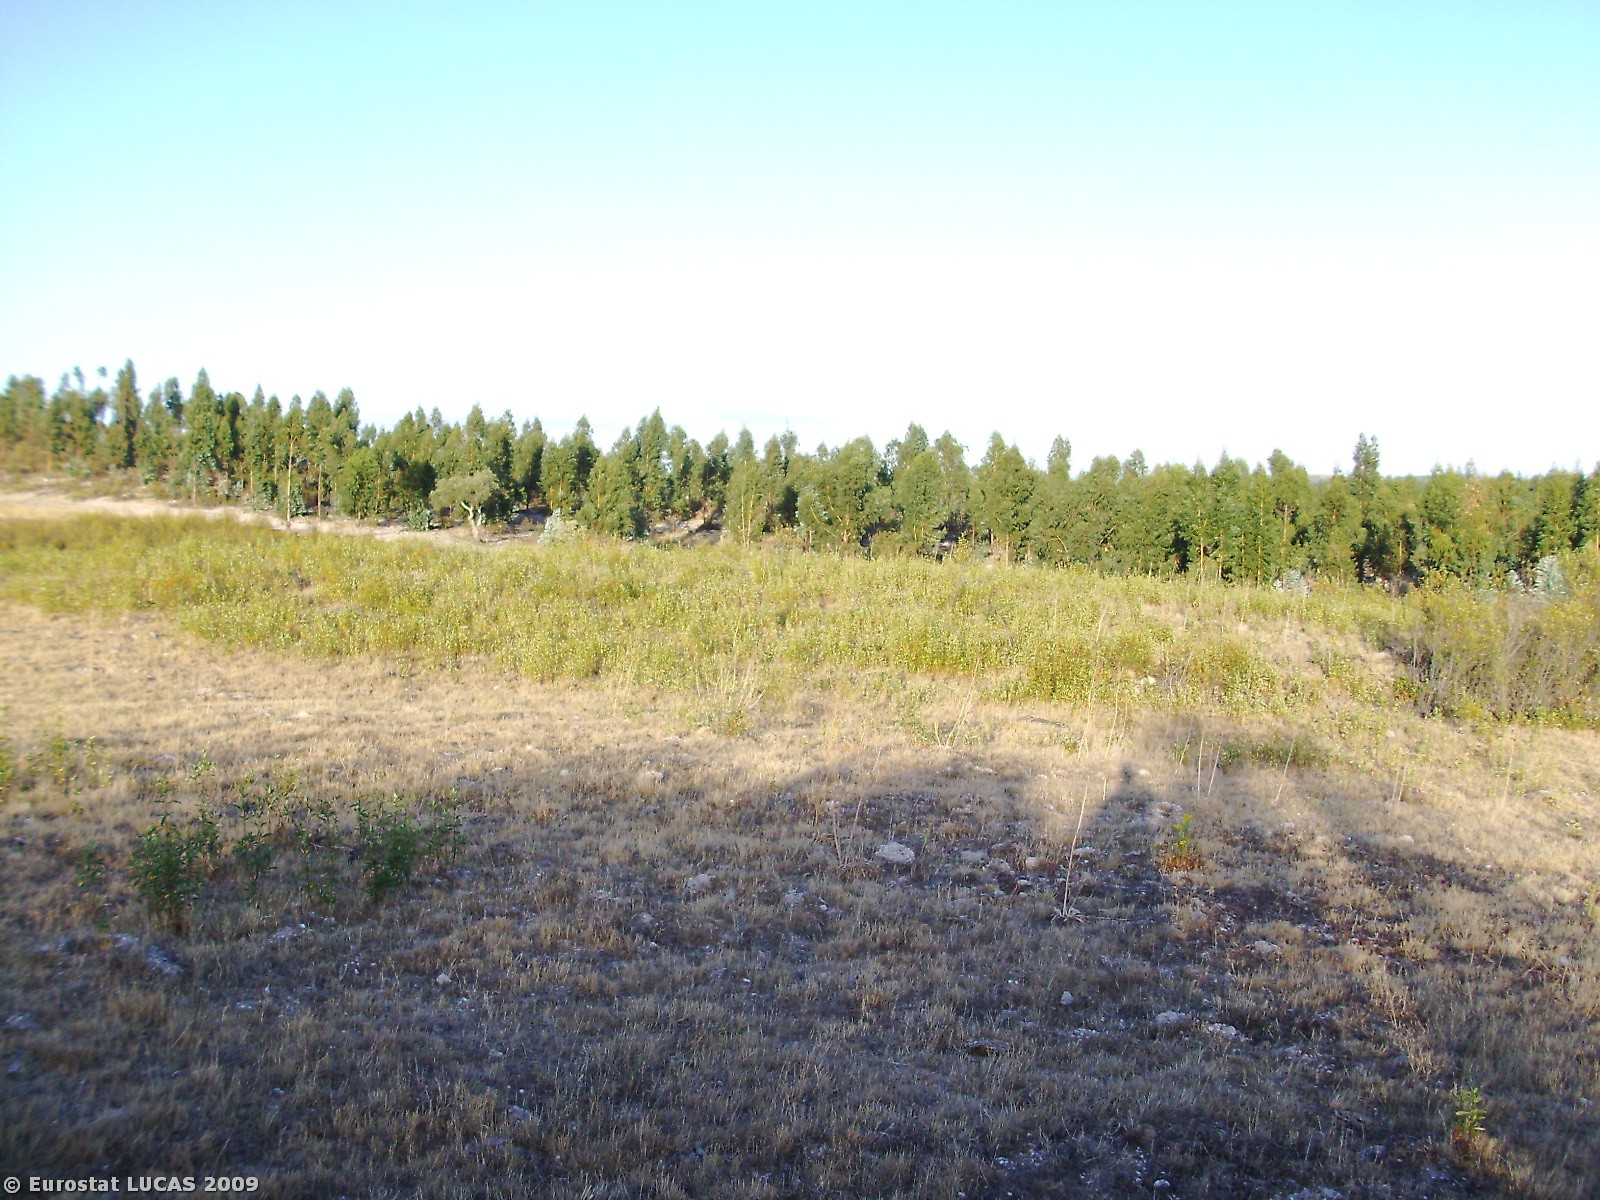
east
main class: Grassland
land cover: Spontaneously vegetated surfaces
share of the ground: 50 - 75 %
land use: Fallow land
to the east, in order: Spontaneously vegetated surfaces; Shrubland with sparse tree cover; Spontaneously vegetated surfaces; Fences; Tracks; Broadleaved woodland
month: June
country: PT
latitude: 38.1046
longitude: -8.4854
